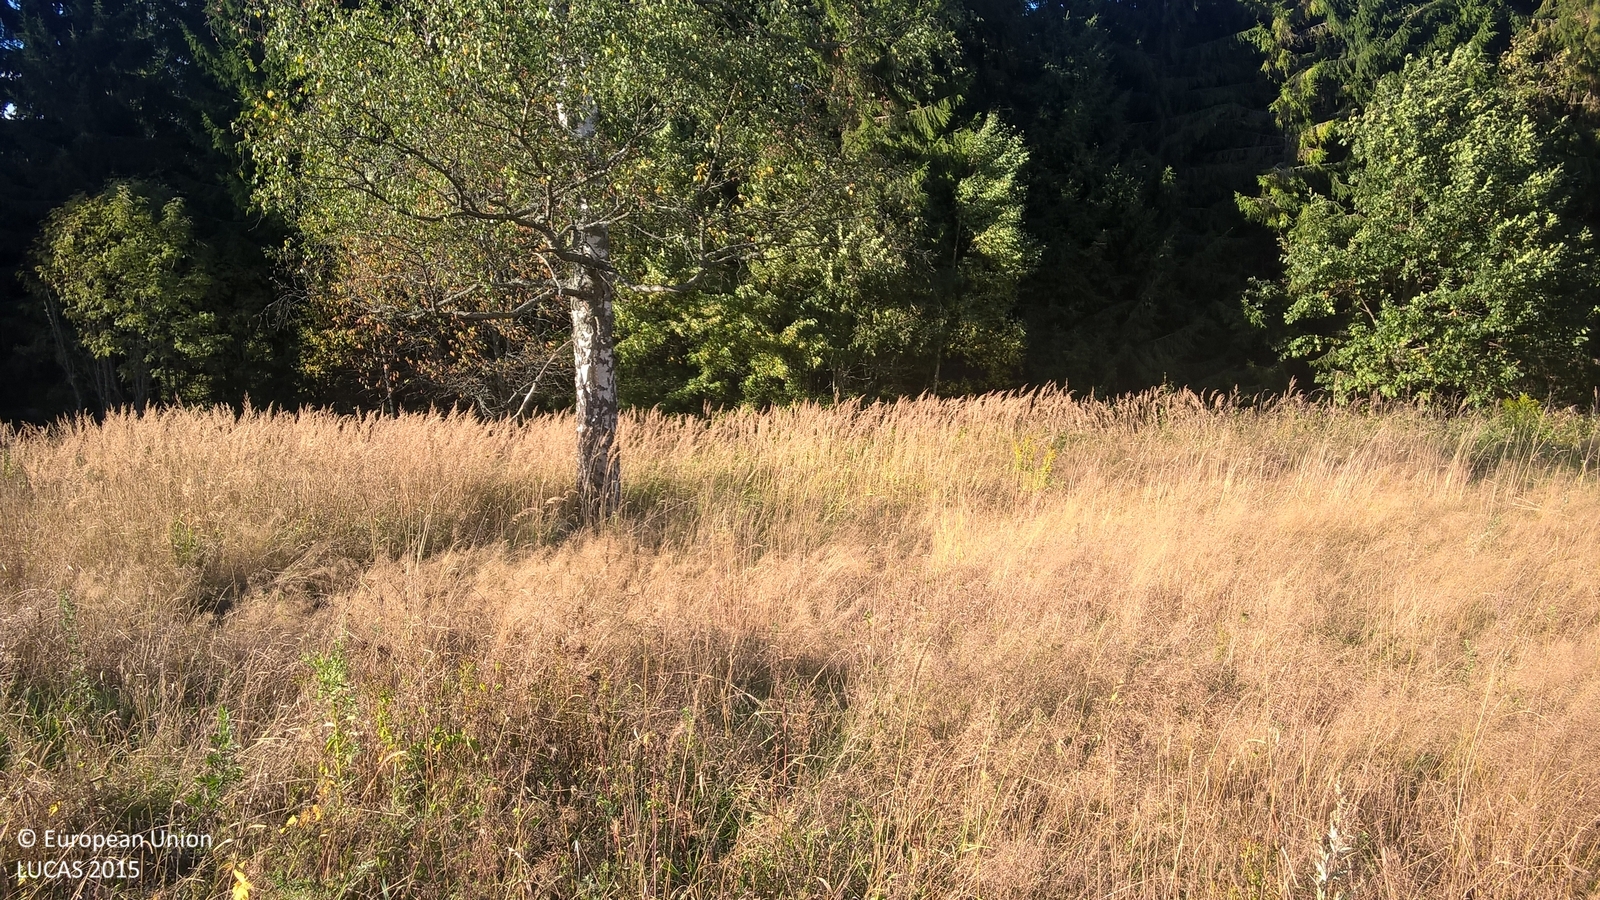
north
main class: Grassland
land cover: Spontaneously vegetated surfaces
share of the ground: > 75 %
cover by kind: herbaceous plants 100 %
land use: Fallow land
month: September
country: LV
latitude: 57.6046
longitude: 25.6657
